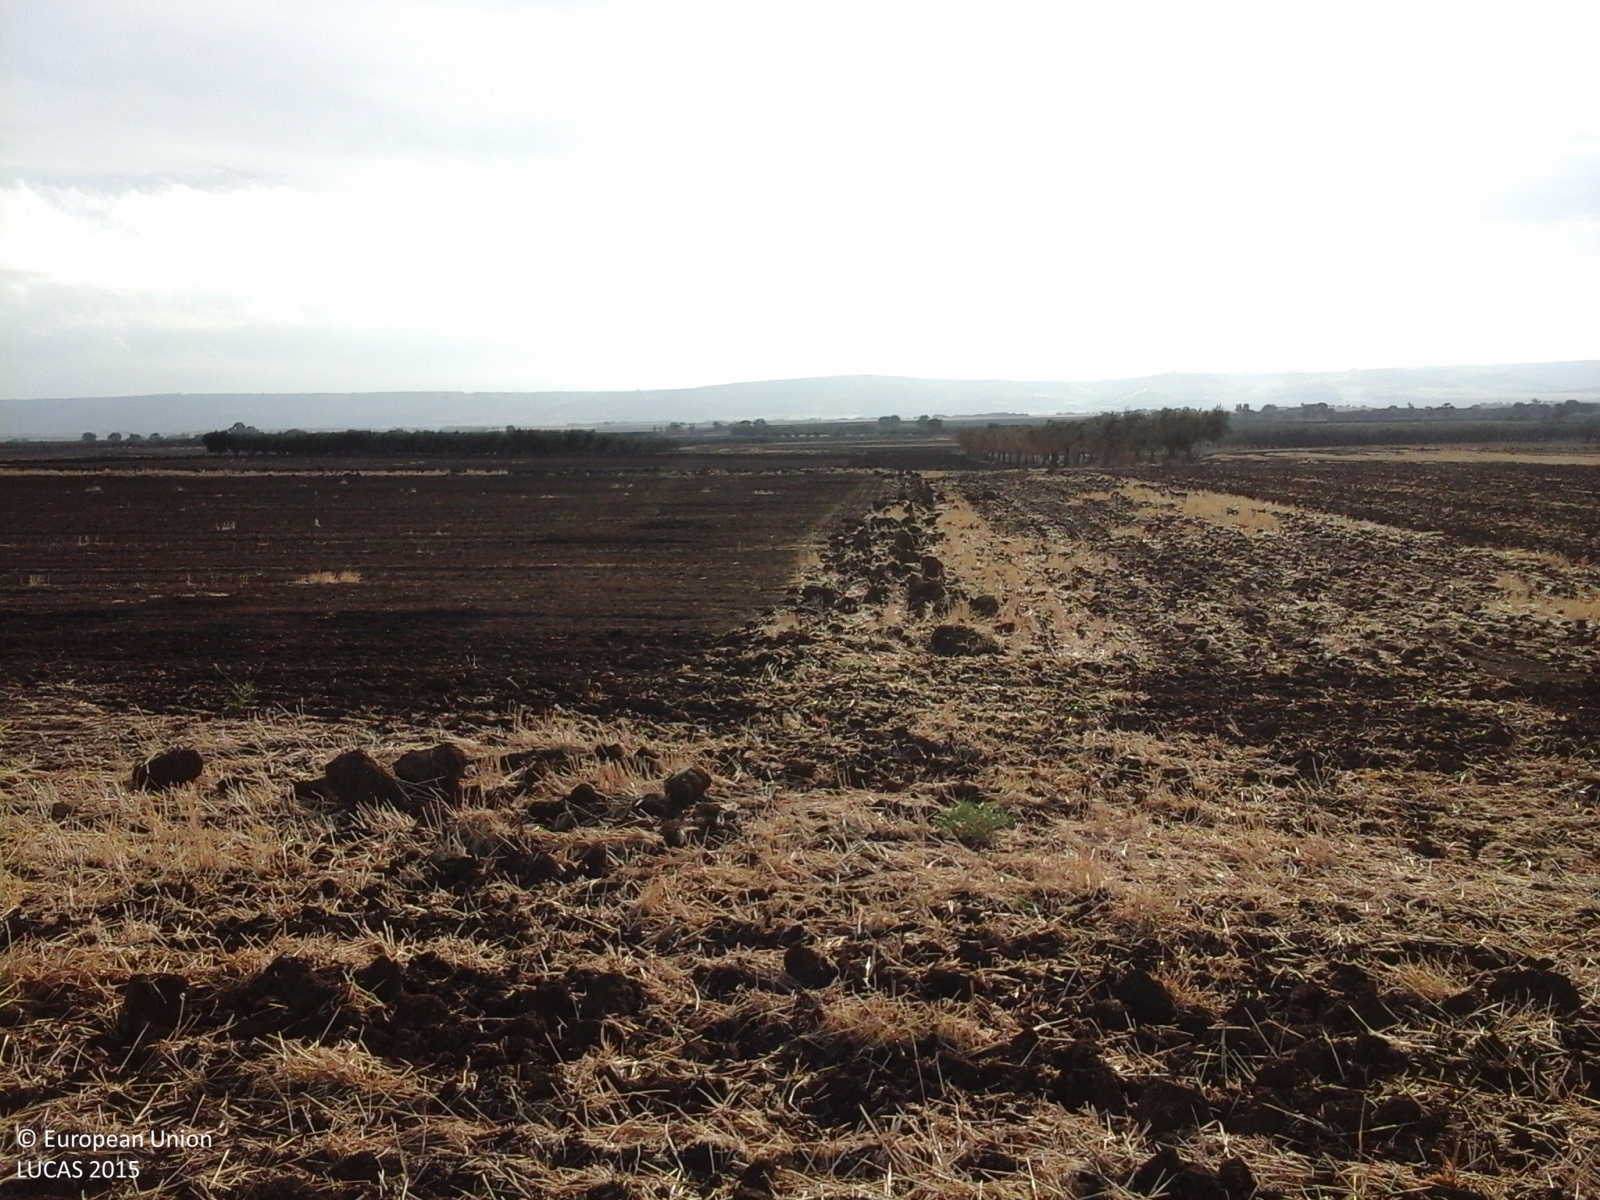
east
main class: Cropland
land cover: Durum wheat
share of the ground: > 75 %
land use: Agriculture (excluding fallow land and kitchen gardens)
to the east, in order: Tracks; Grass margins; Durum wheat; Grass margins; Tracks; Grass margins; Durum wheat
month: September
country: IT
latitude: 41.7631
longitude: 15.1438
